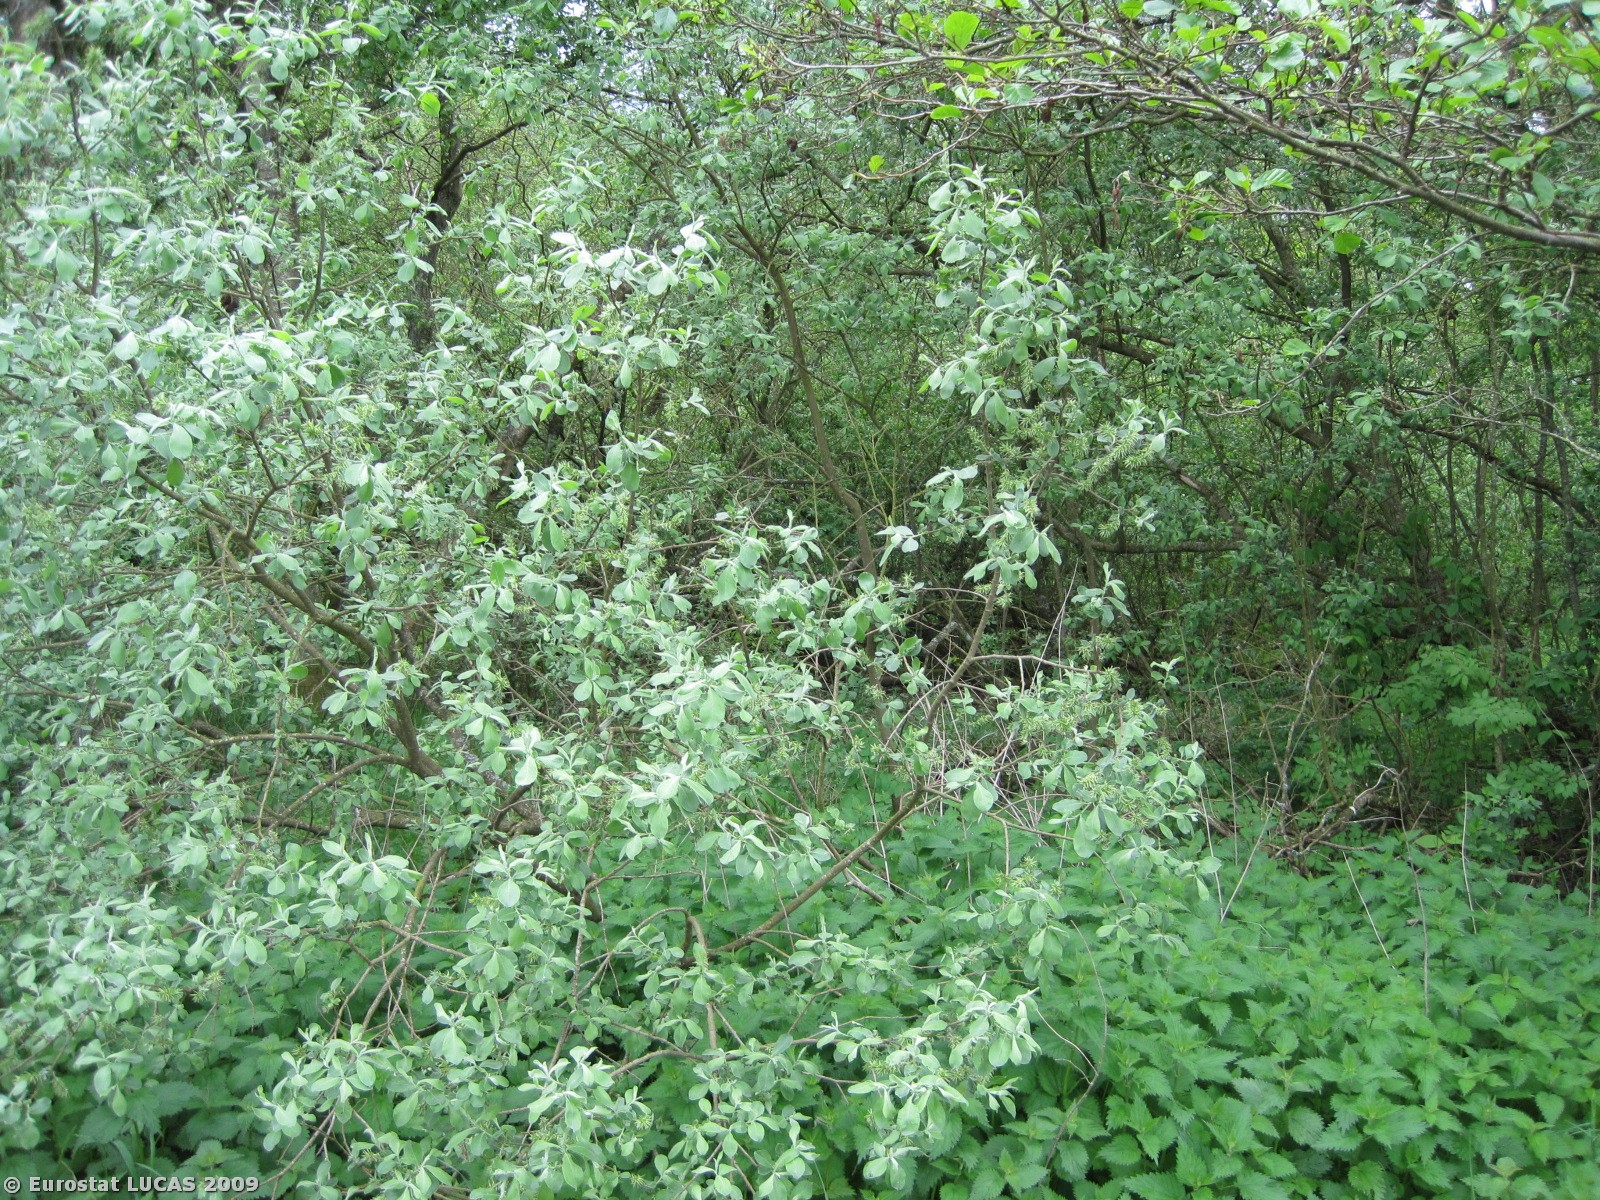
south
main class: Cropland
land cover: Maize
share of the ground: < 10 %
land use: Agriculture (excluding fallow land and kitchen gardens)
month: May
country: DK
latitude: 56.7270
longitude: 10.0490
